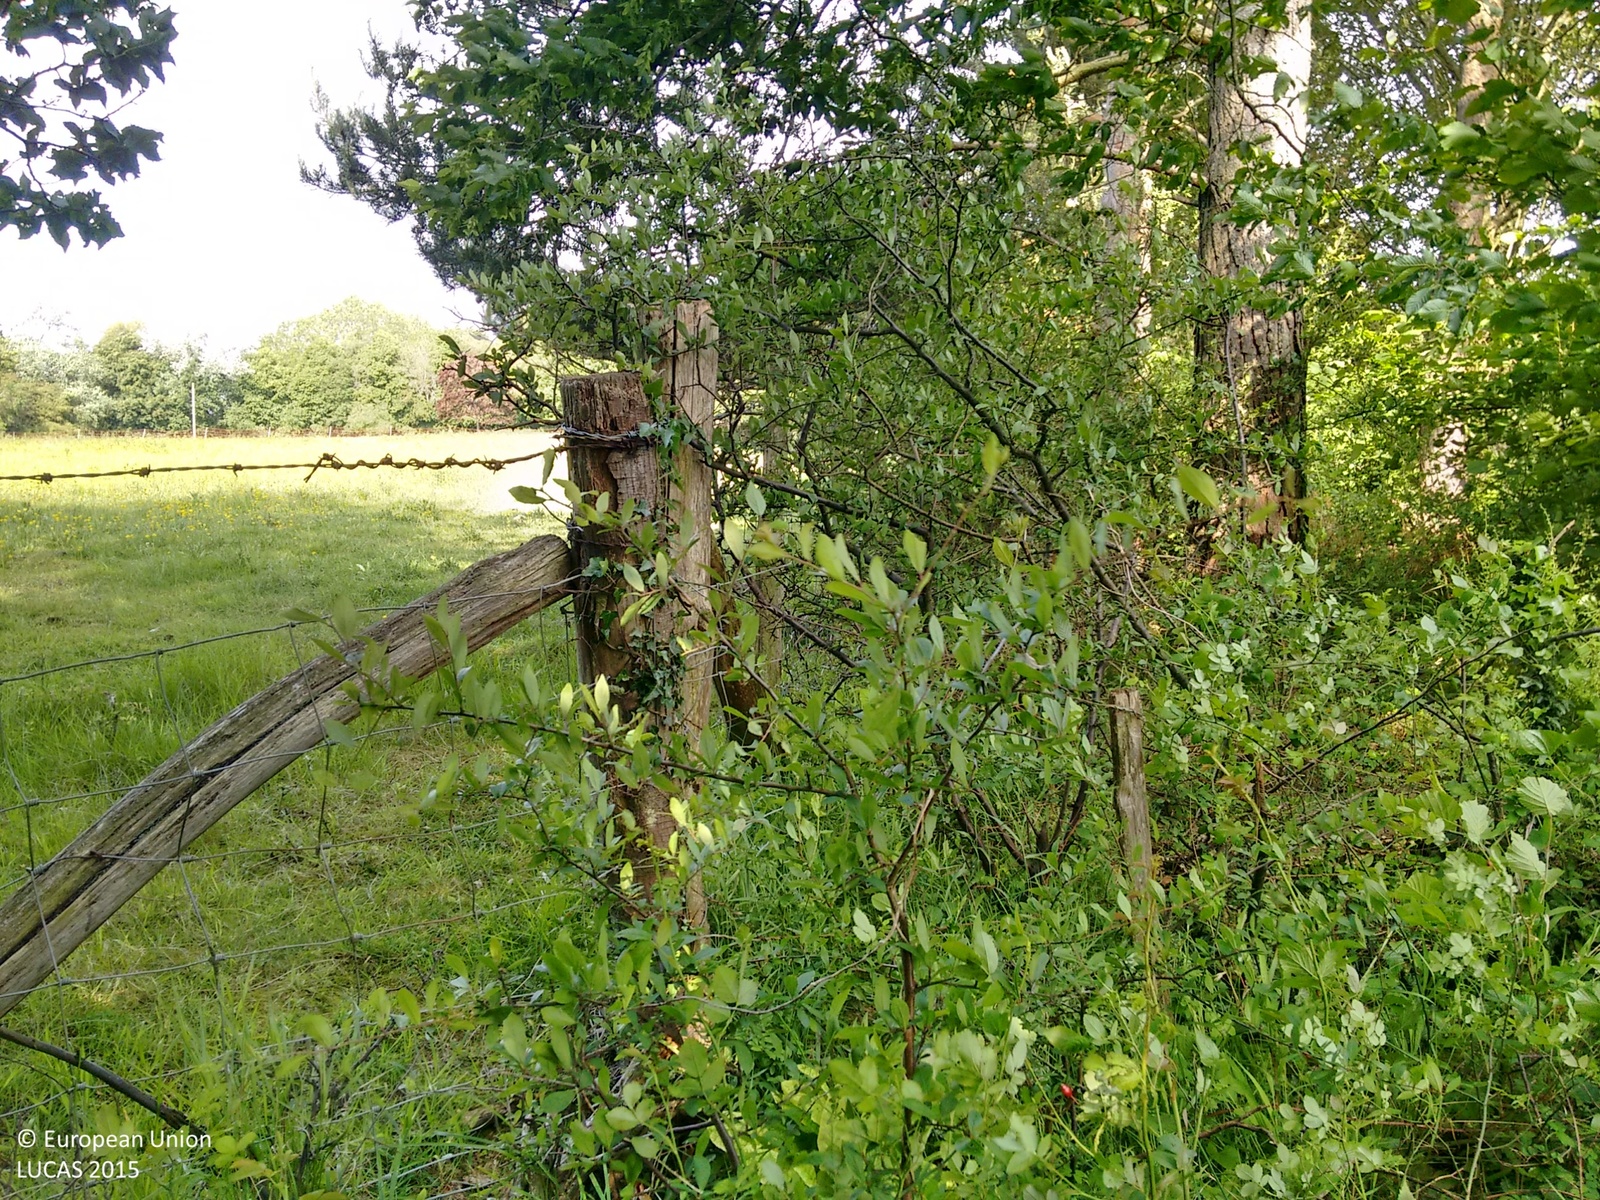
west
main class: Grassland
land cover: Grassland without tree/shrub cover
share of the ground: > 75 %
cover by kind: herbaceous plants 100 %
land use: Agriculture (excluding fallow land and kitchen gardens)
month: June
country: GB
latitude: 50.9864
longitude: 0.5564
